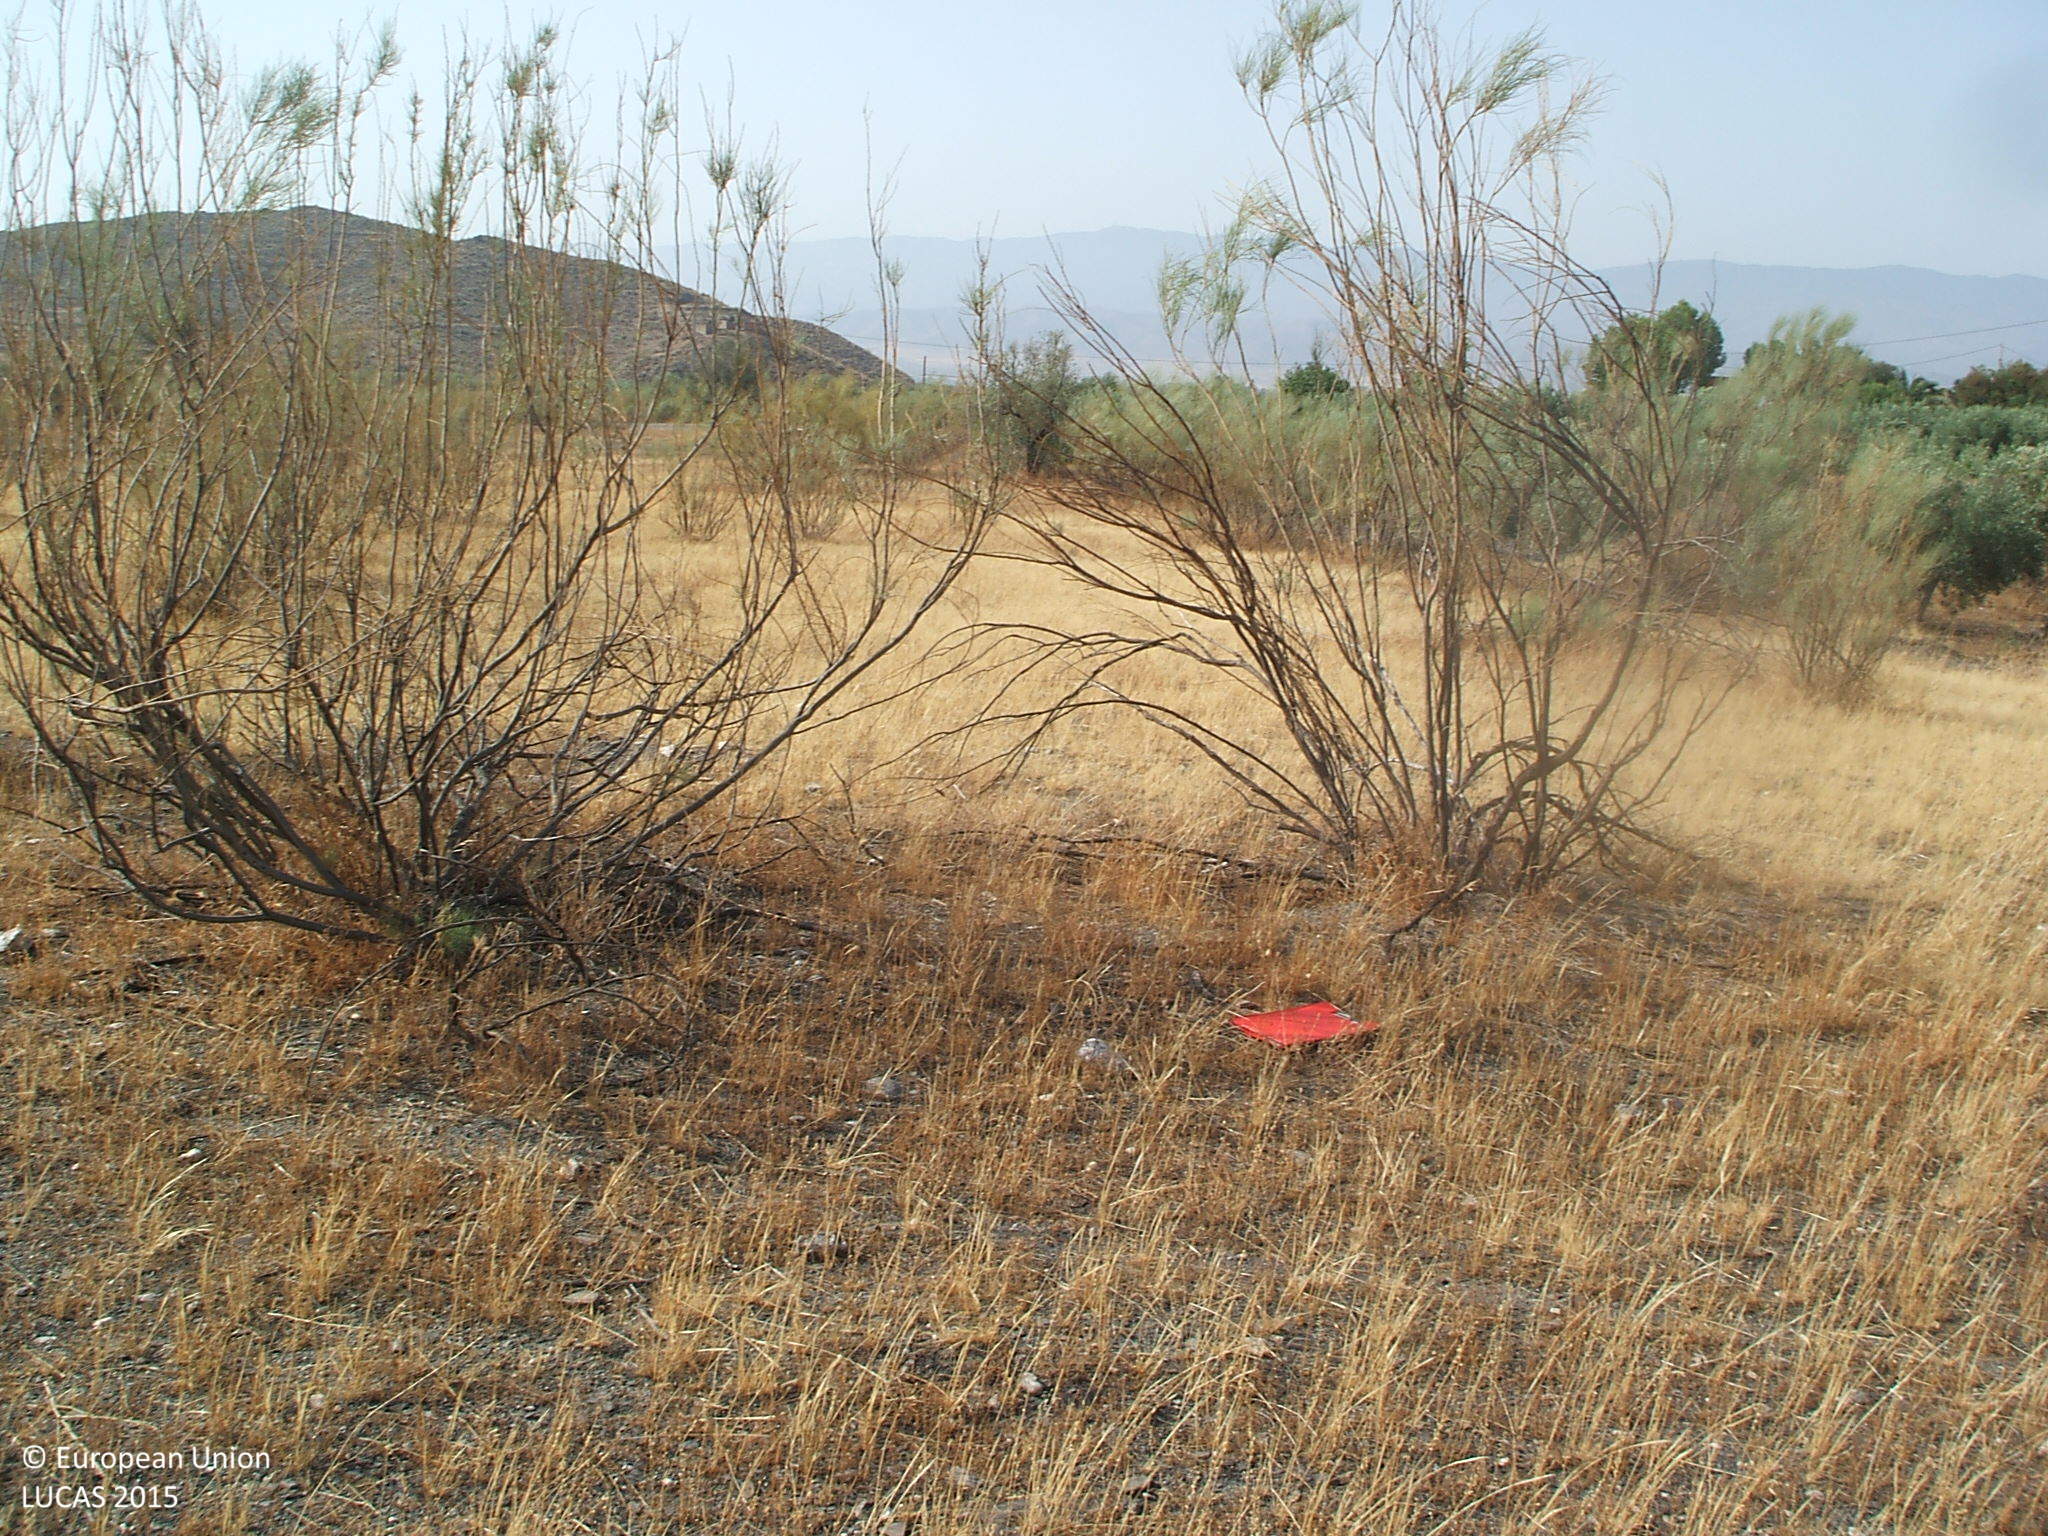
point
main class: Shrubland
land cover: Shrubland without tree cover
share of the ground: 10 - 25 %
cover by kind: herbaceous plants 85 %, shrubs 15 %
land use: Semi-natural and natural areas not in use
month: July
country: ES
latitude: 37.1227
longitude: -2.3481
